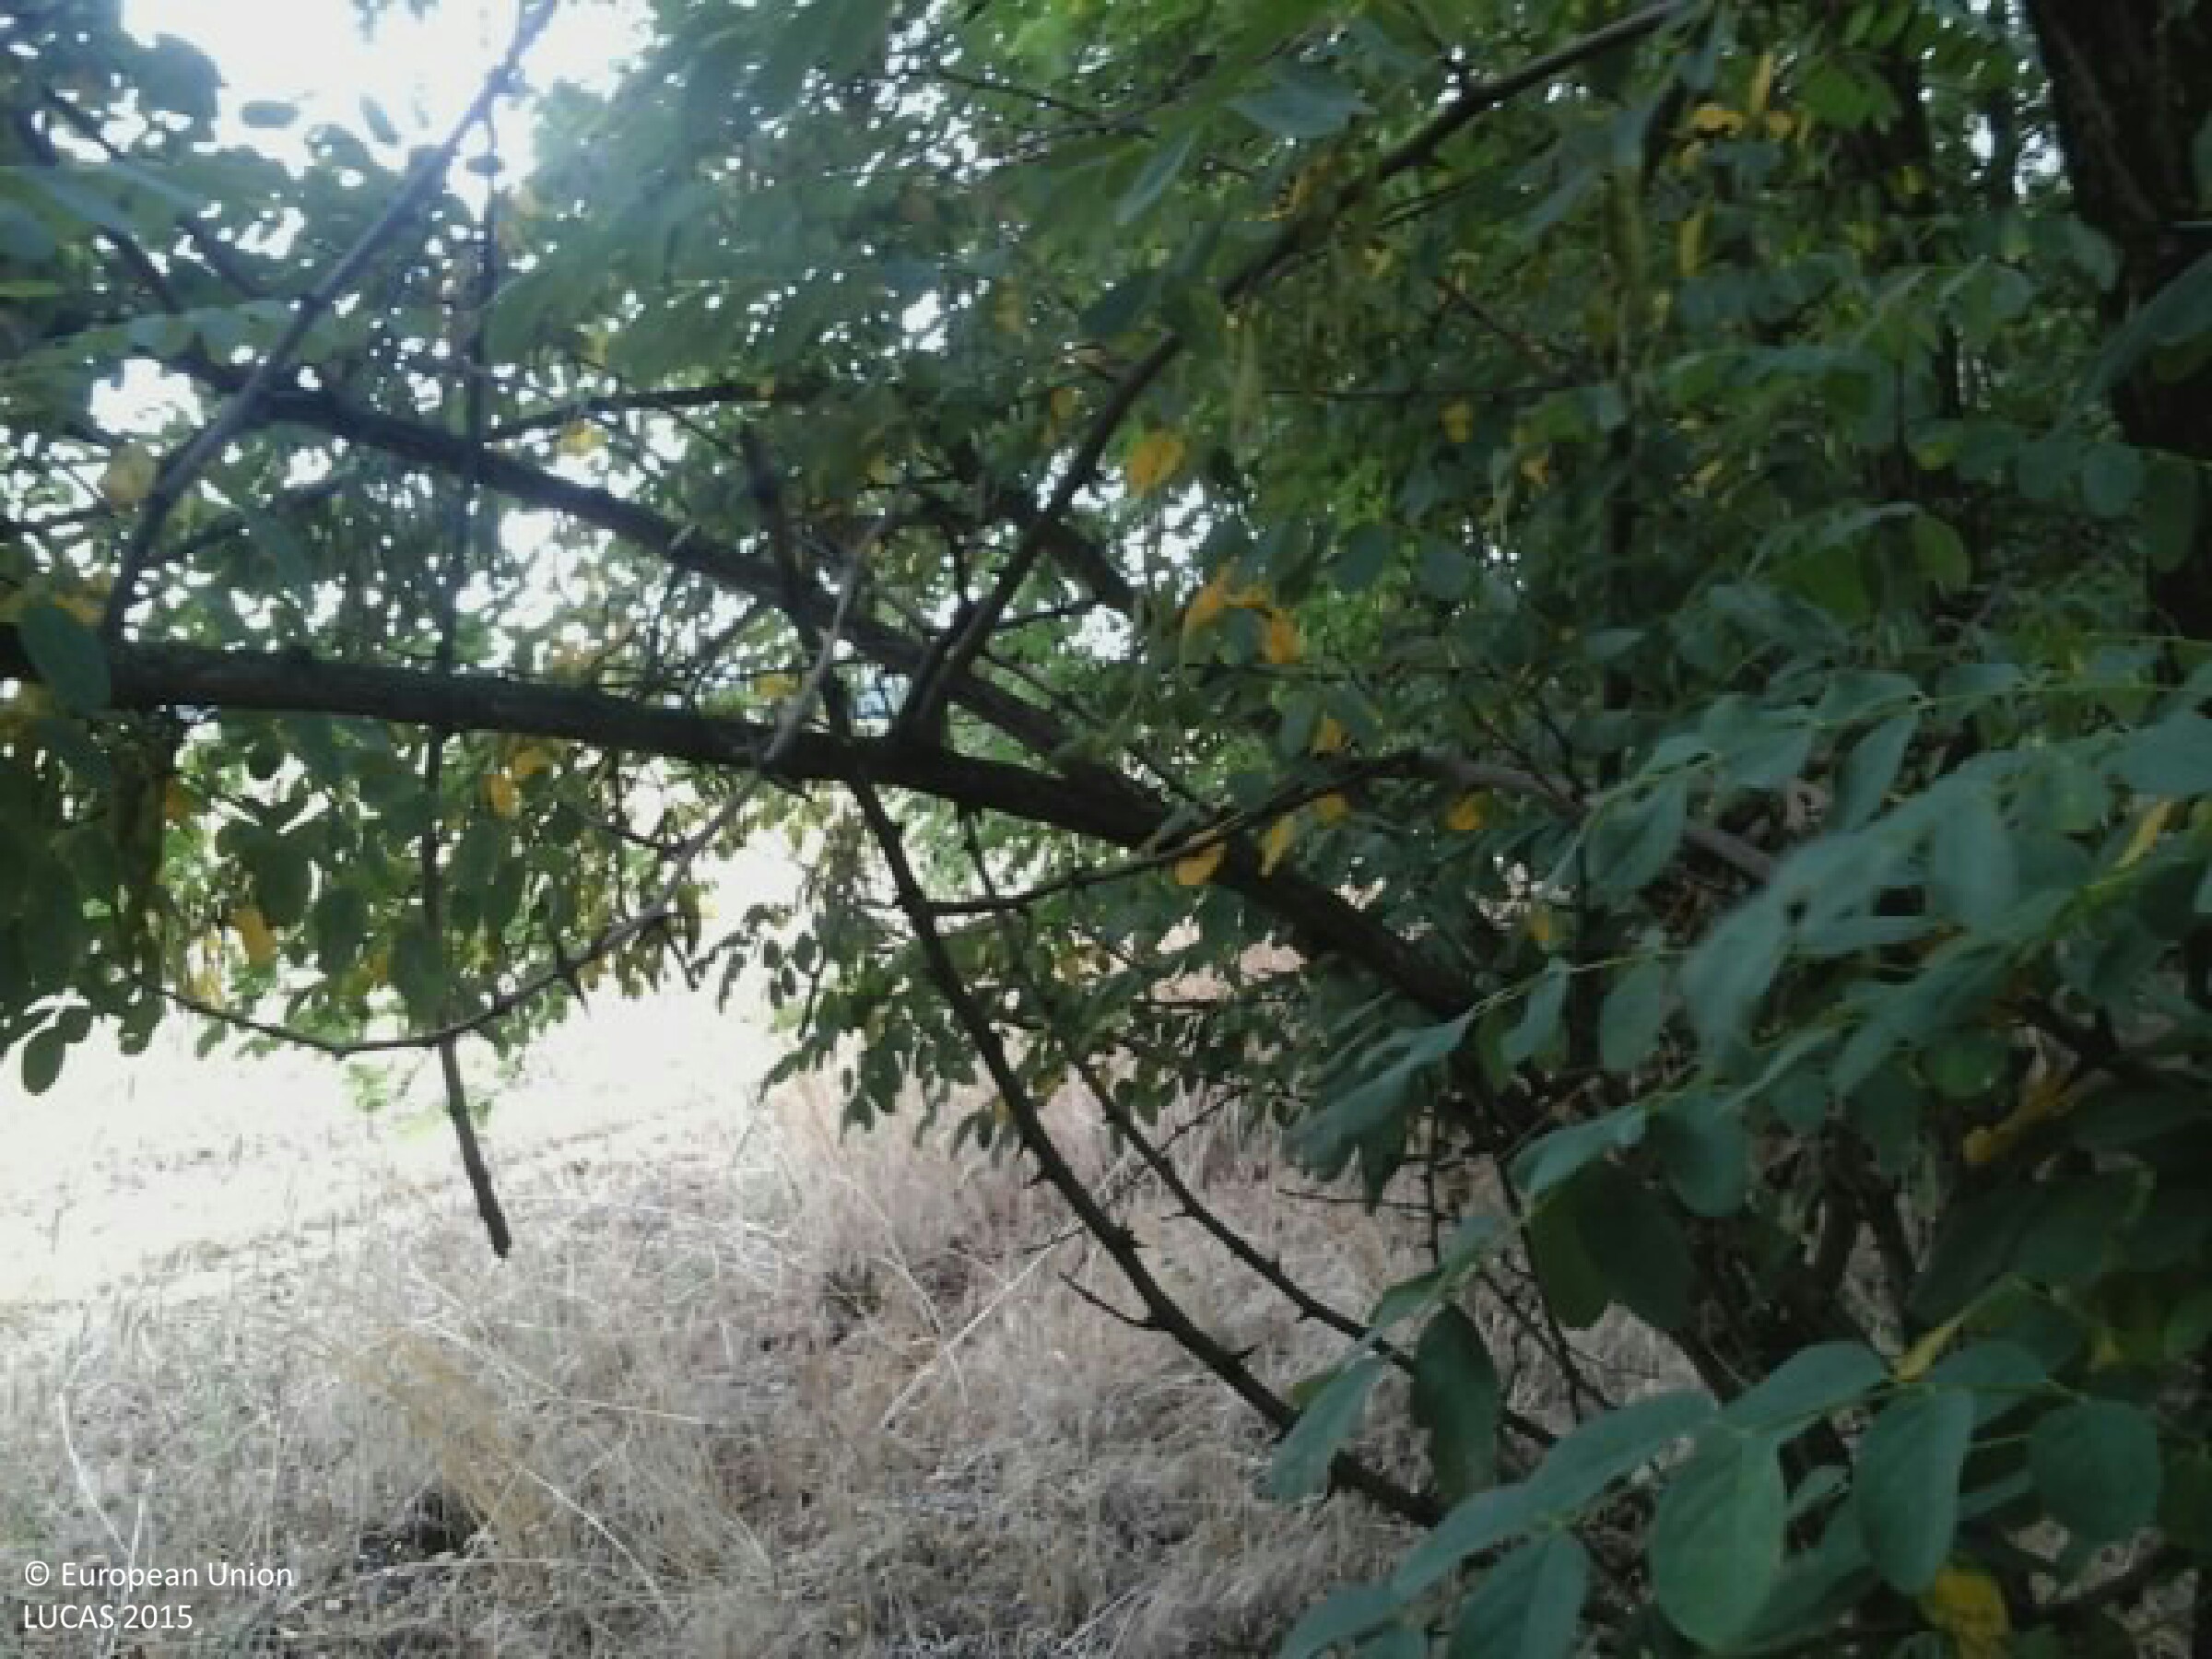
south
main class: Woodland
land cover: Broadleaved woodland
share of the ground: > 75 %
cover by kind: broadleaved forest trees 75 %, herbaceous plants 25 %
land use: Forestry
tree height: > 5 m
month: July
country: HU
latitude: 47.0200
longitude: 19.8502
